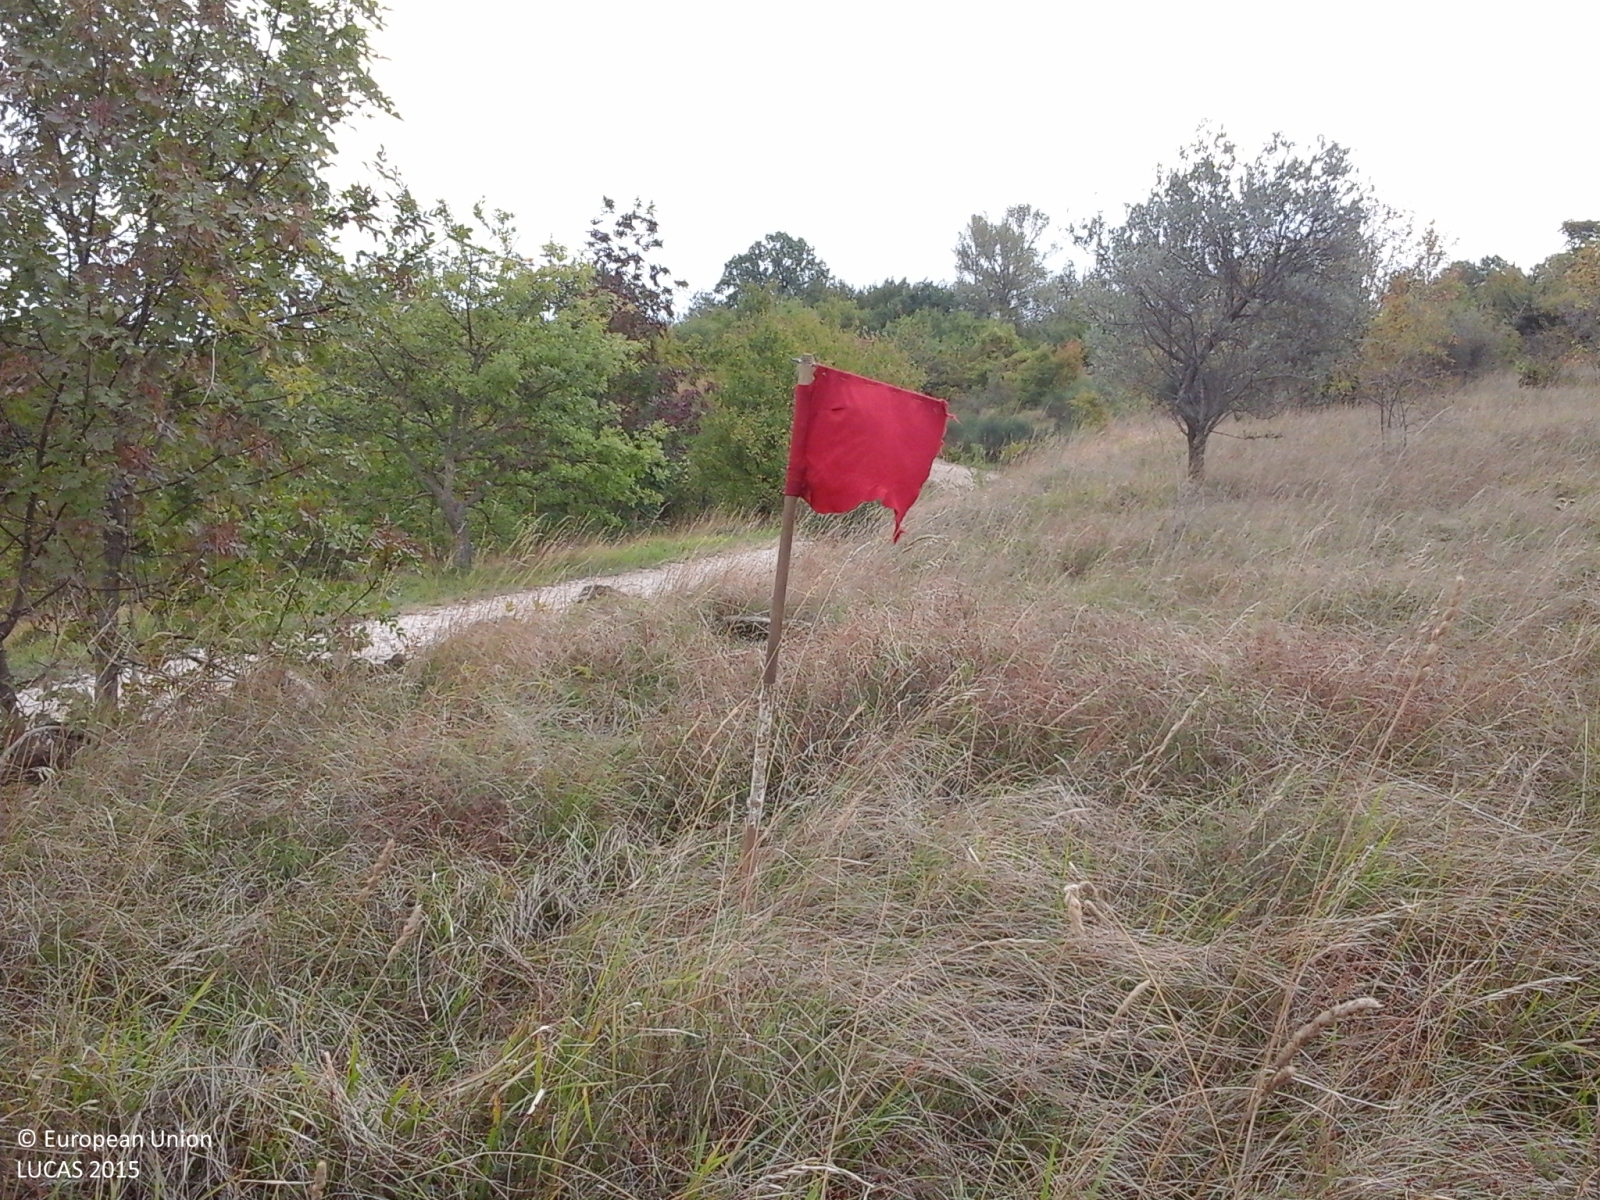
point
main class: Grassland
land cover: Grassland with sparse tree/shrub cover
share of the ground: > 75 %
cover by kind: herbaceous plants 85 %, shrubs 10 %, broadleaved forest trees 5 %
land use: Agriculture (excluding fallow land and kitchen gardens)
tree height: > 5 m
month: October
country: IT
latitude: 43.1822
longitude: 12.5396
